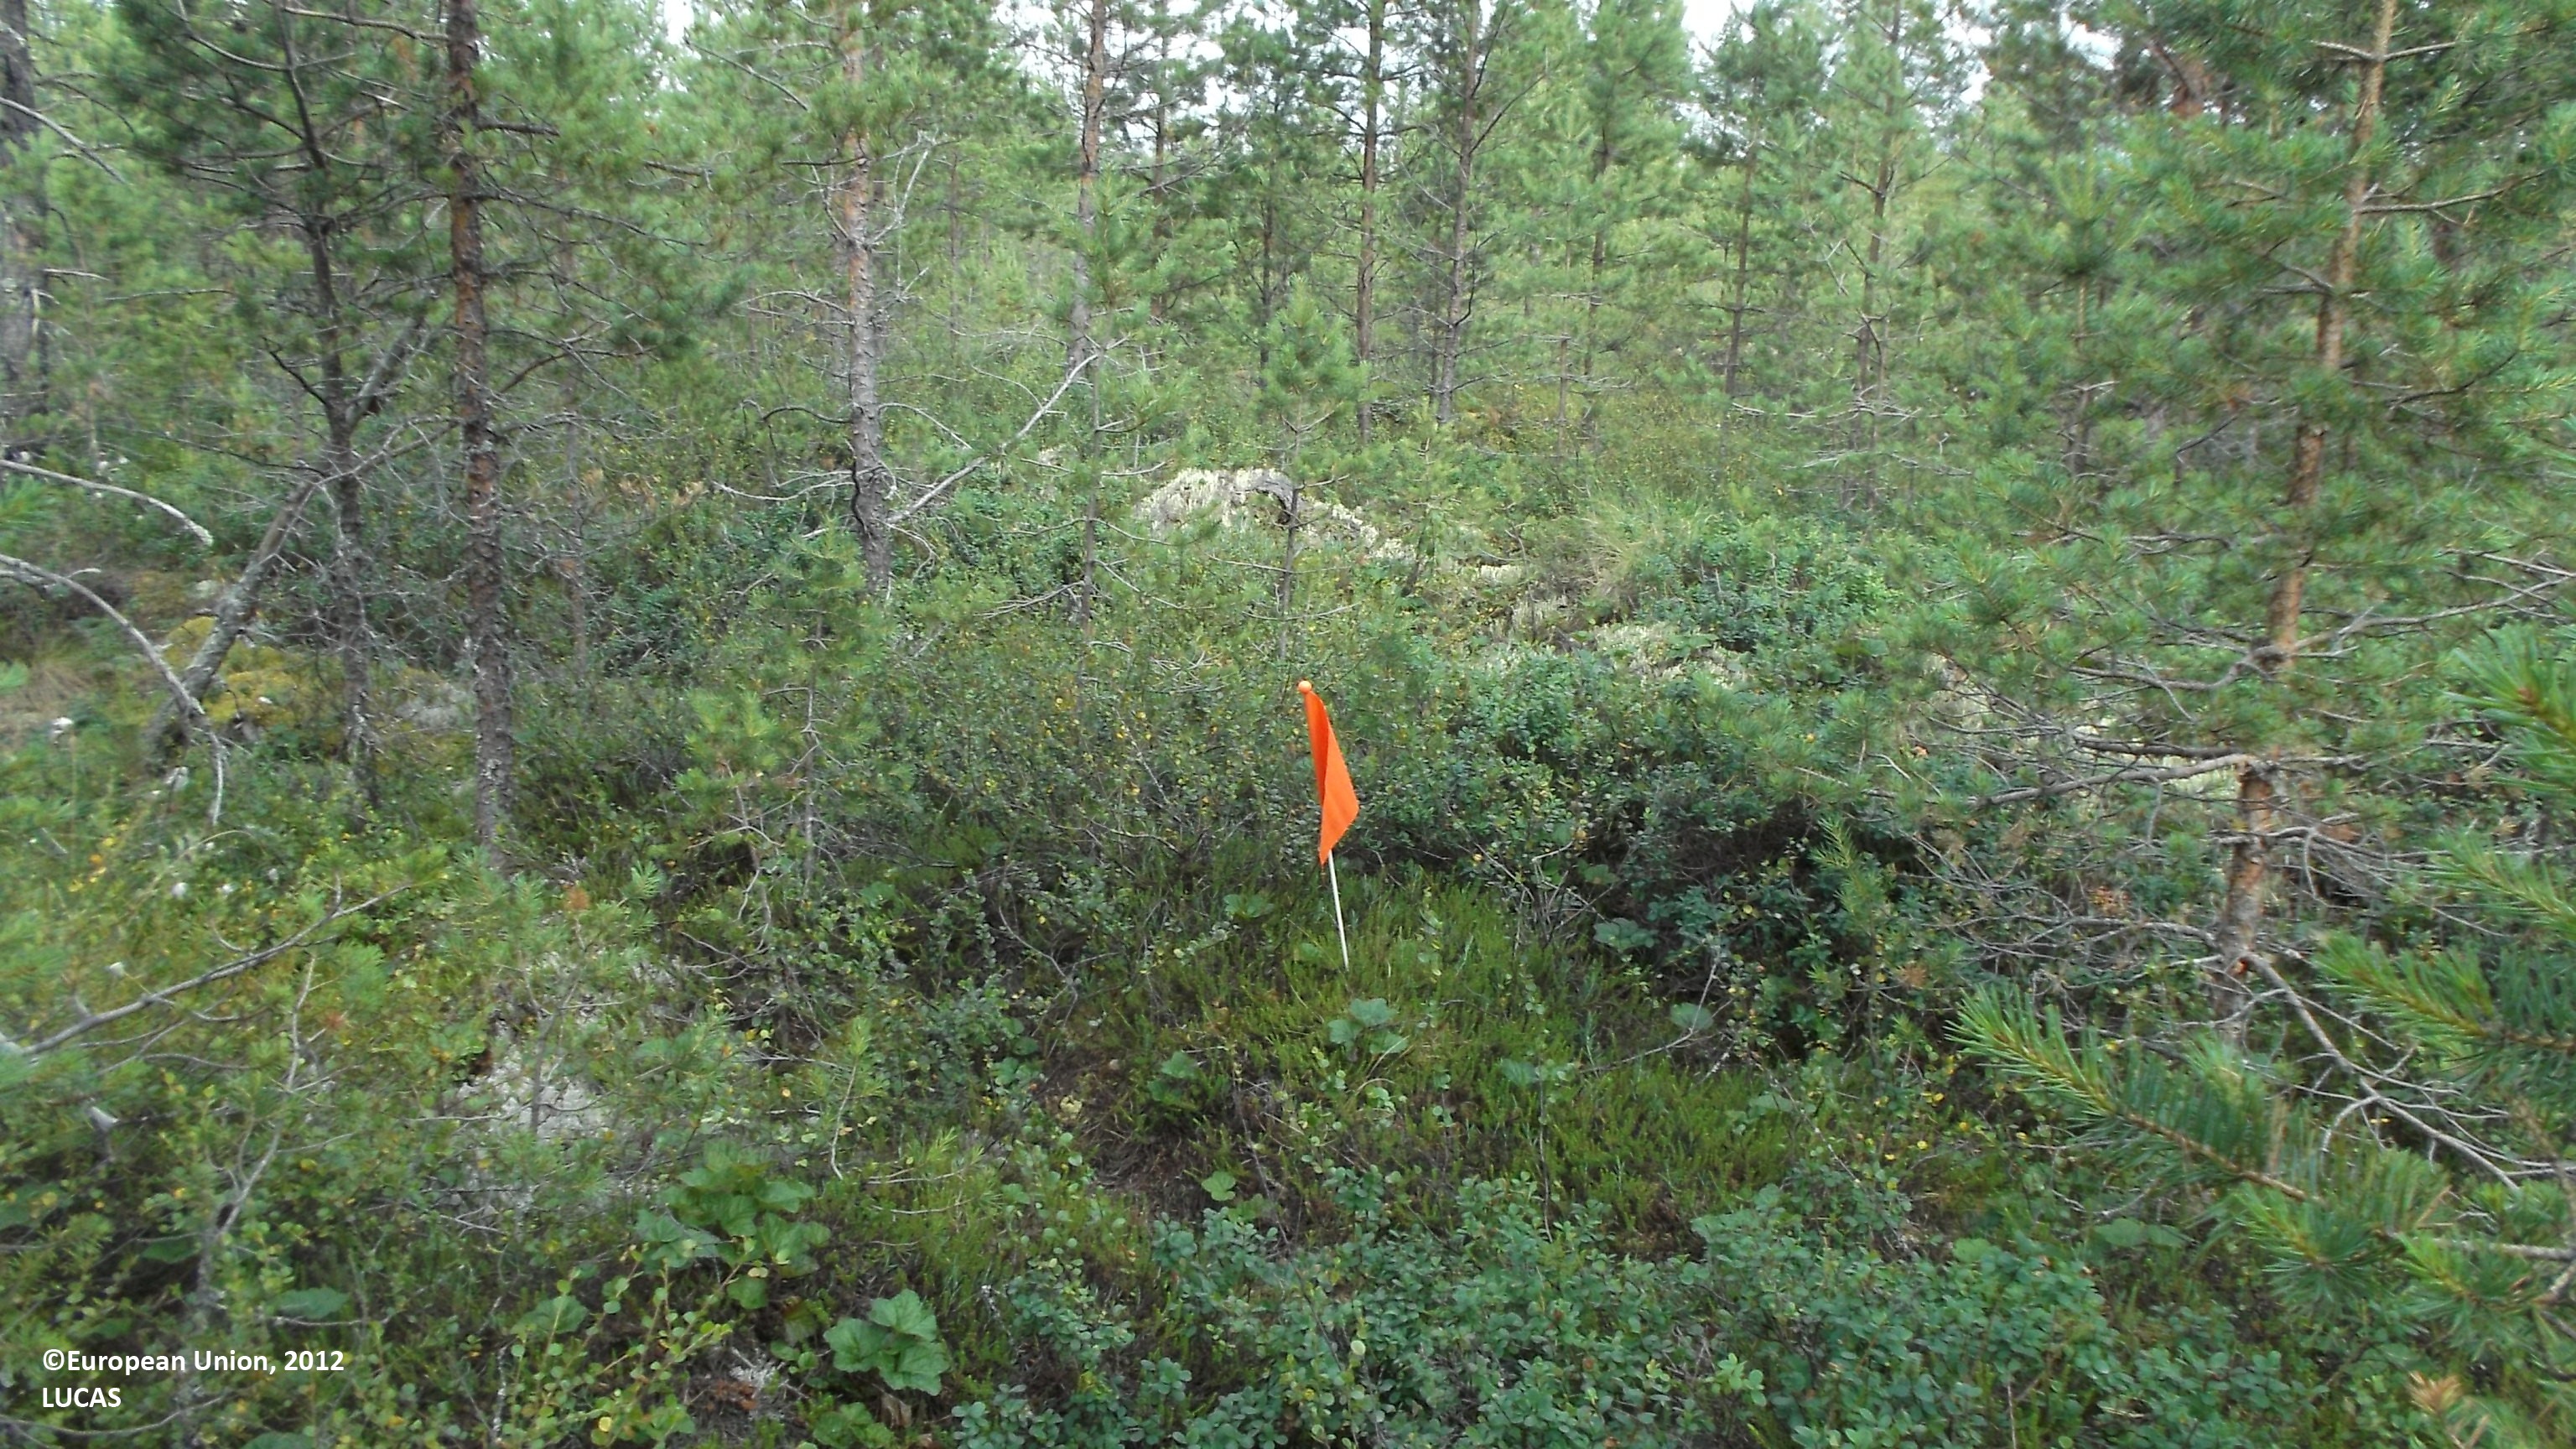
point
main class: Woodland
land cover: Pine dominated coniferous woodland
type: mire and swamp forests
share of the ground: 25 - 50 %
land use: Forestry
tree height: > 5 m
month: July
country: FI
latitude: 63.5823
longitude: 23.2527
